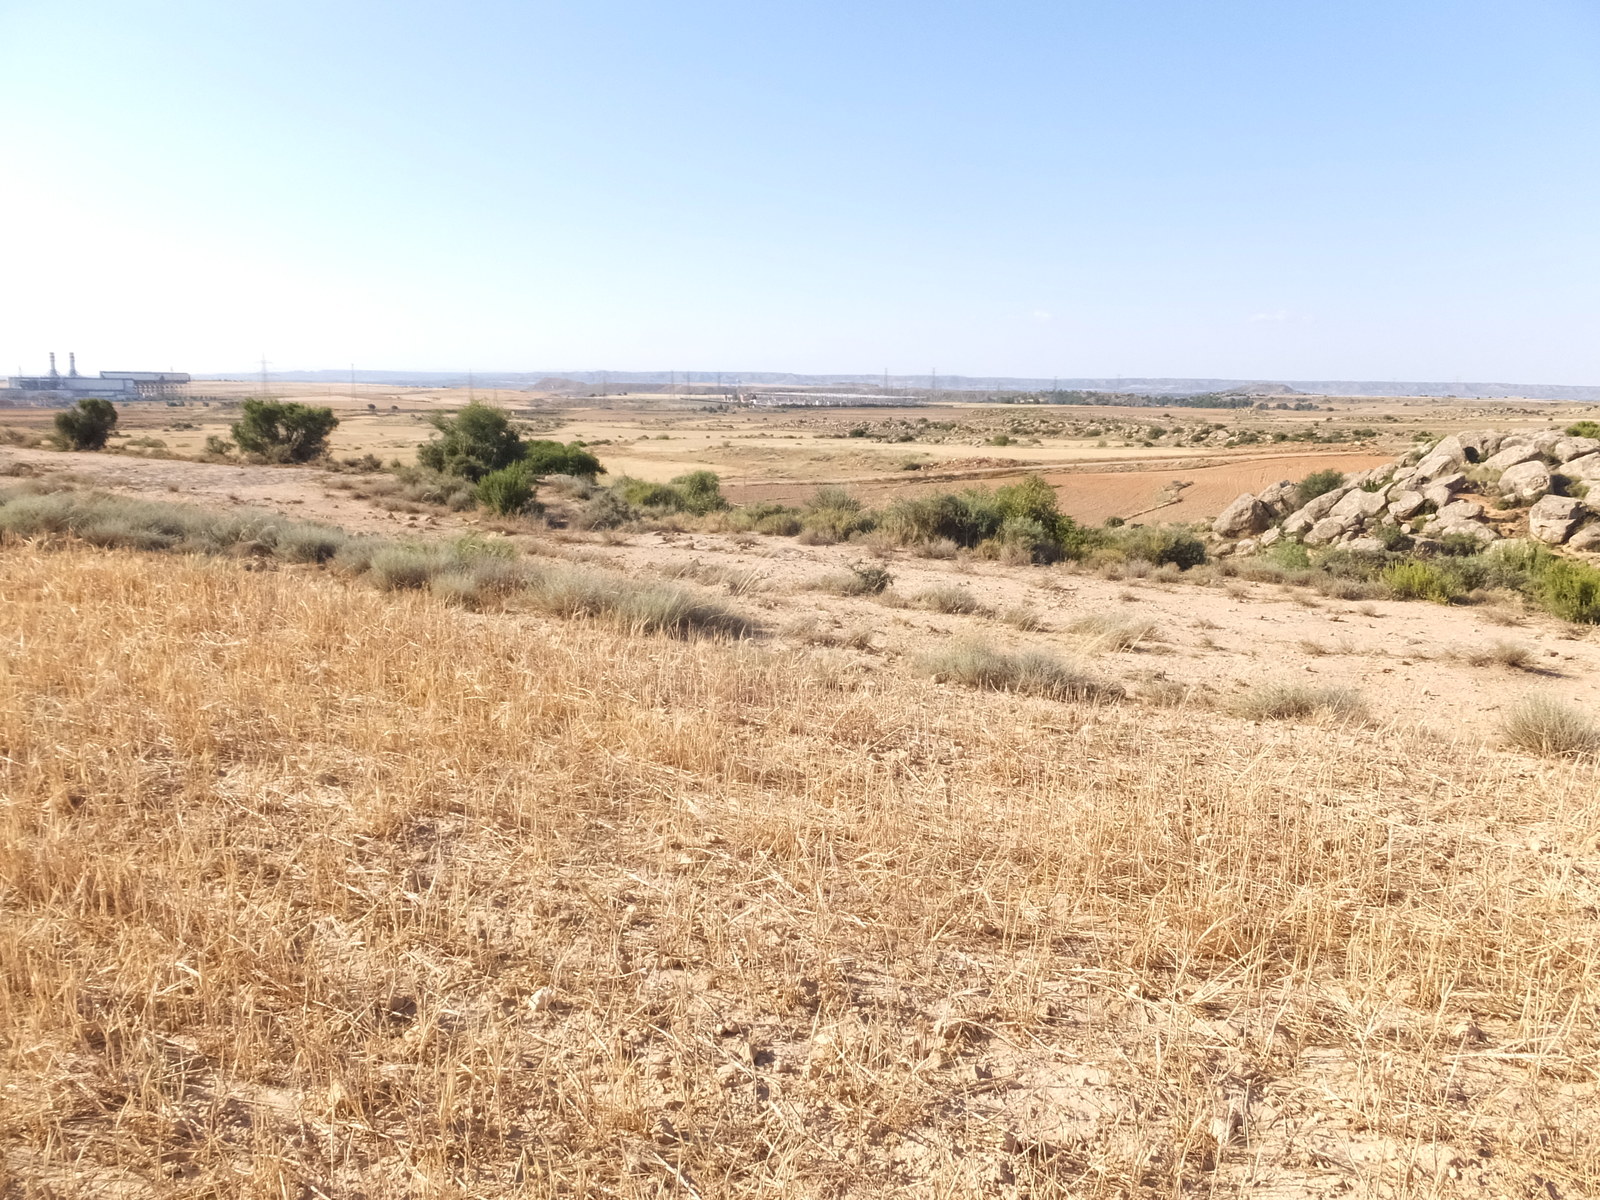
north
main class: Cropland
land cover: Barley
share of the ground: > 75 %
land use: Agriculture (excluding fallow land and kitchen gardens)
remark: Harvested field
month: June
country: ES
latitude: 41.2014
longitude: -0.2809
